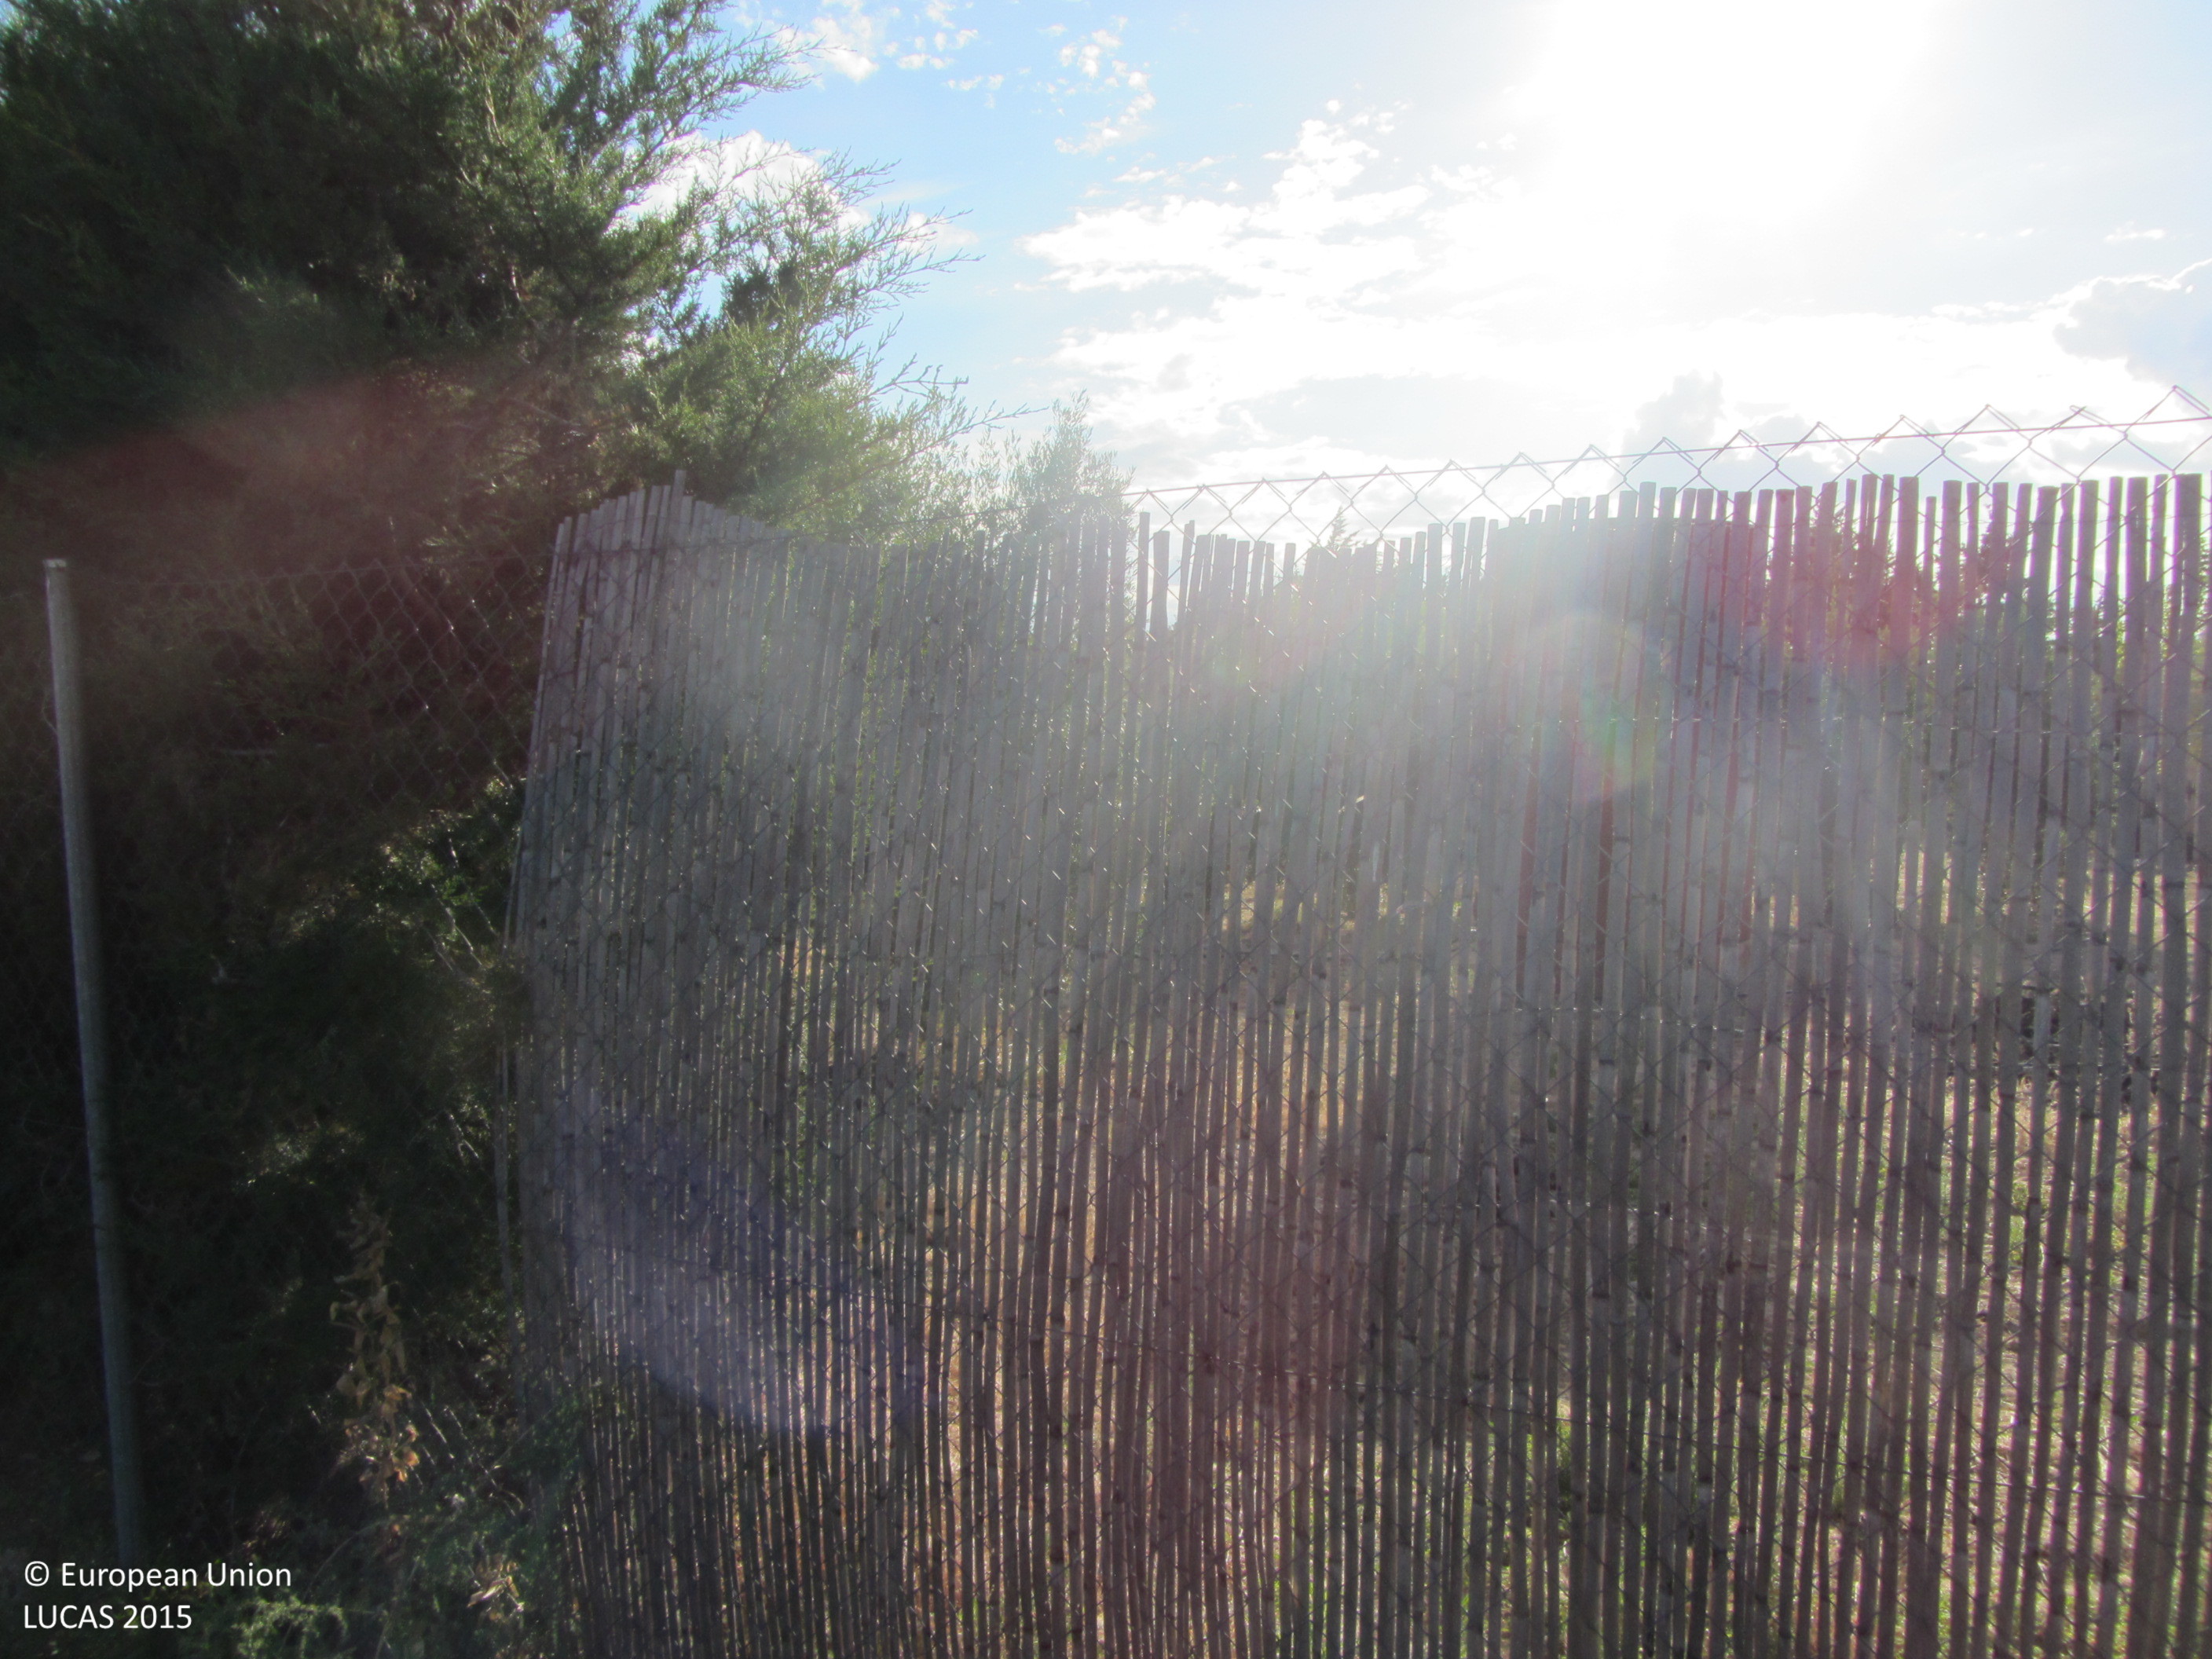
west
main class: Cropland
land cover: Olive groves
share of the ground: 25 - 50 %
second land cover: Other bare soil
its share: > 75 %
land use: Agriculture (excluding fallow land and kitchen gardens)
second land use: Residential
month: June
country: ES
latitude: 38.0196
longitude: -3.4307
